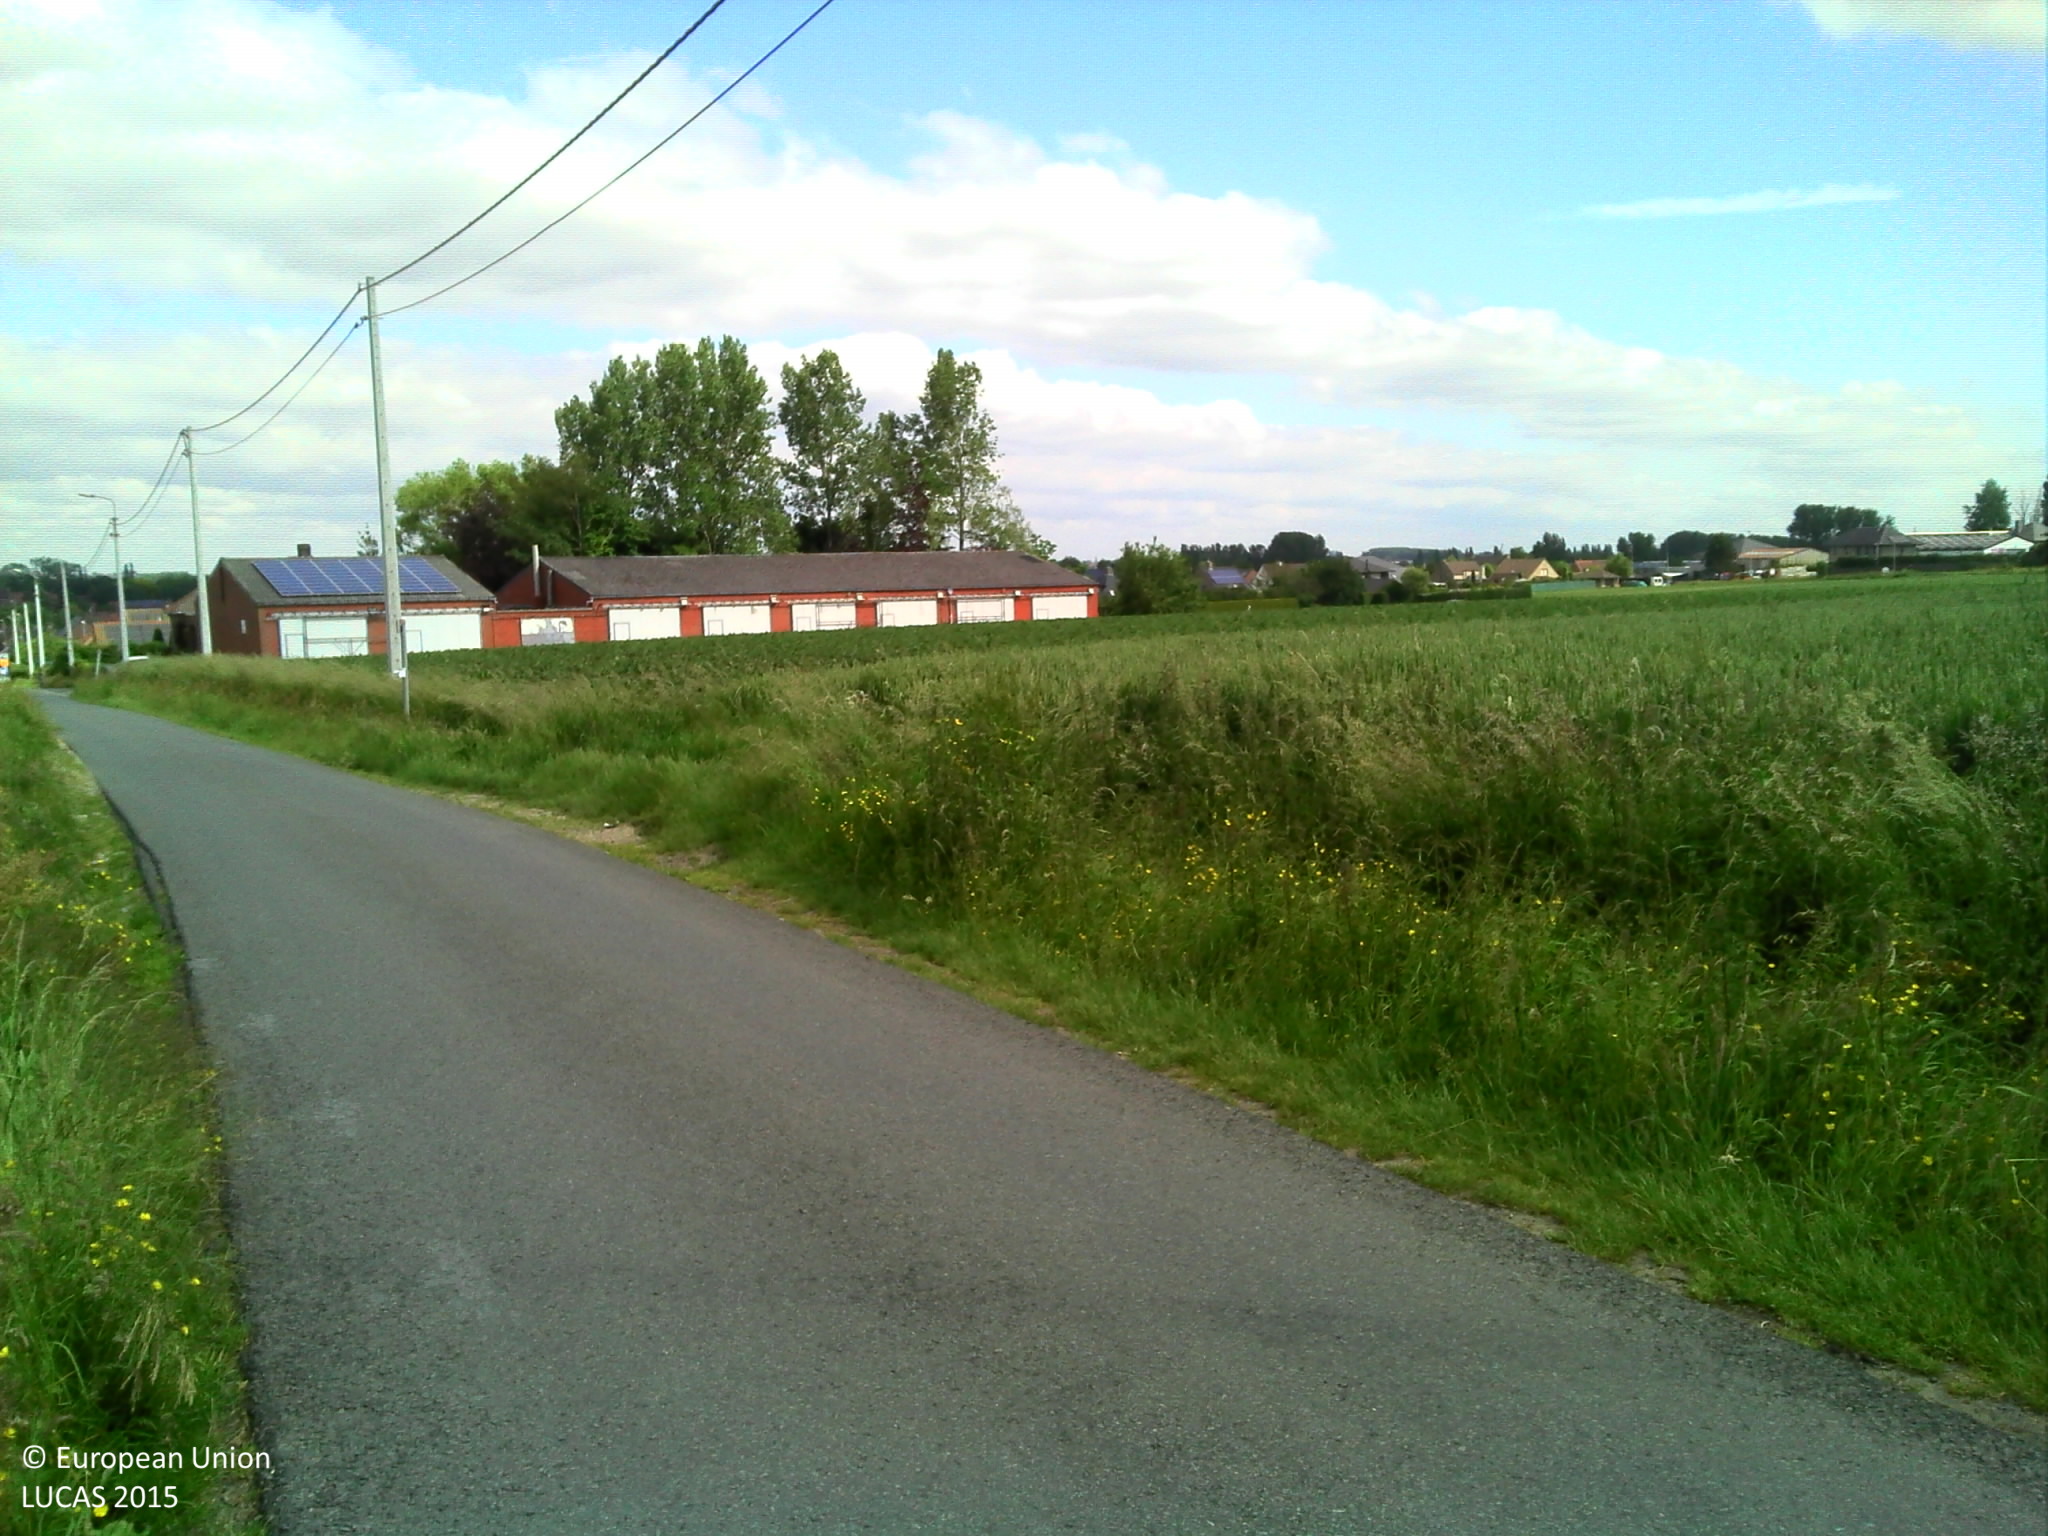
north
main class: Grassland
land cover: Grassland without tree/shrub cover
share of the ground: > 75 %
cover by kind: herbaceous plants 100 %
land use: Agriculture (excluding fallow land and kitchen gardens)
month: June
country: BE
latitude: 50.8416
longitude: 3.1028
